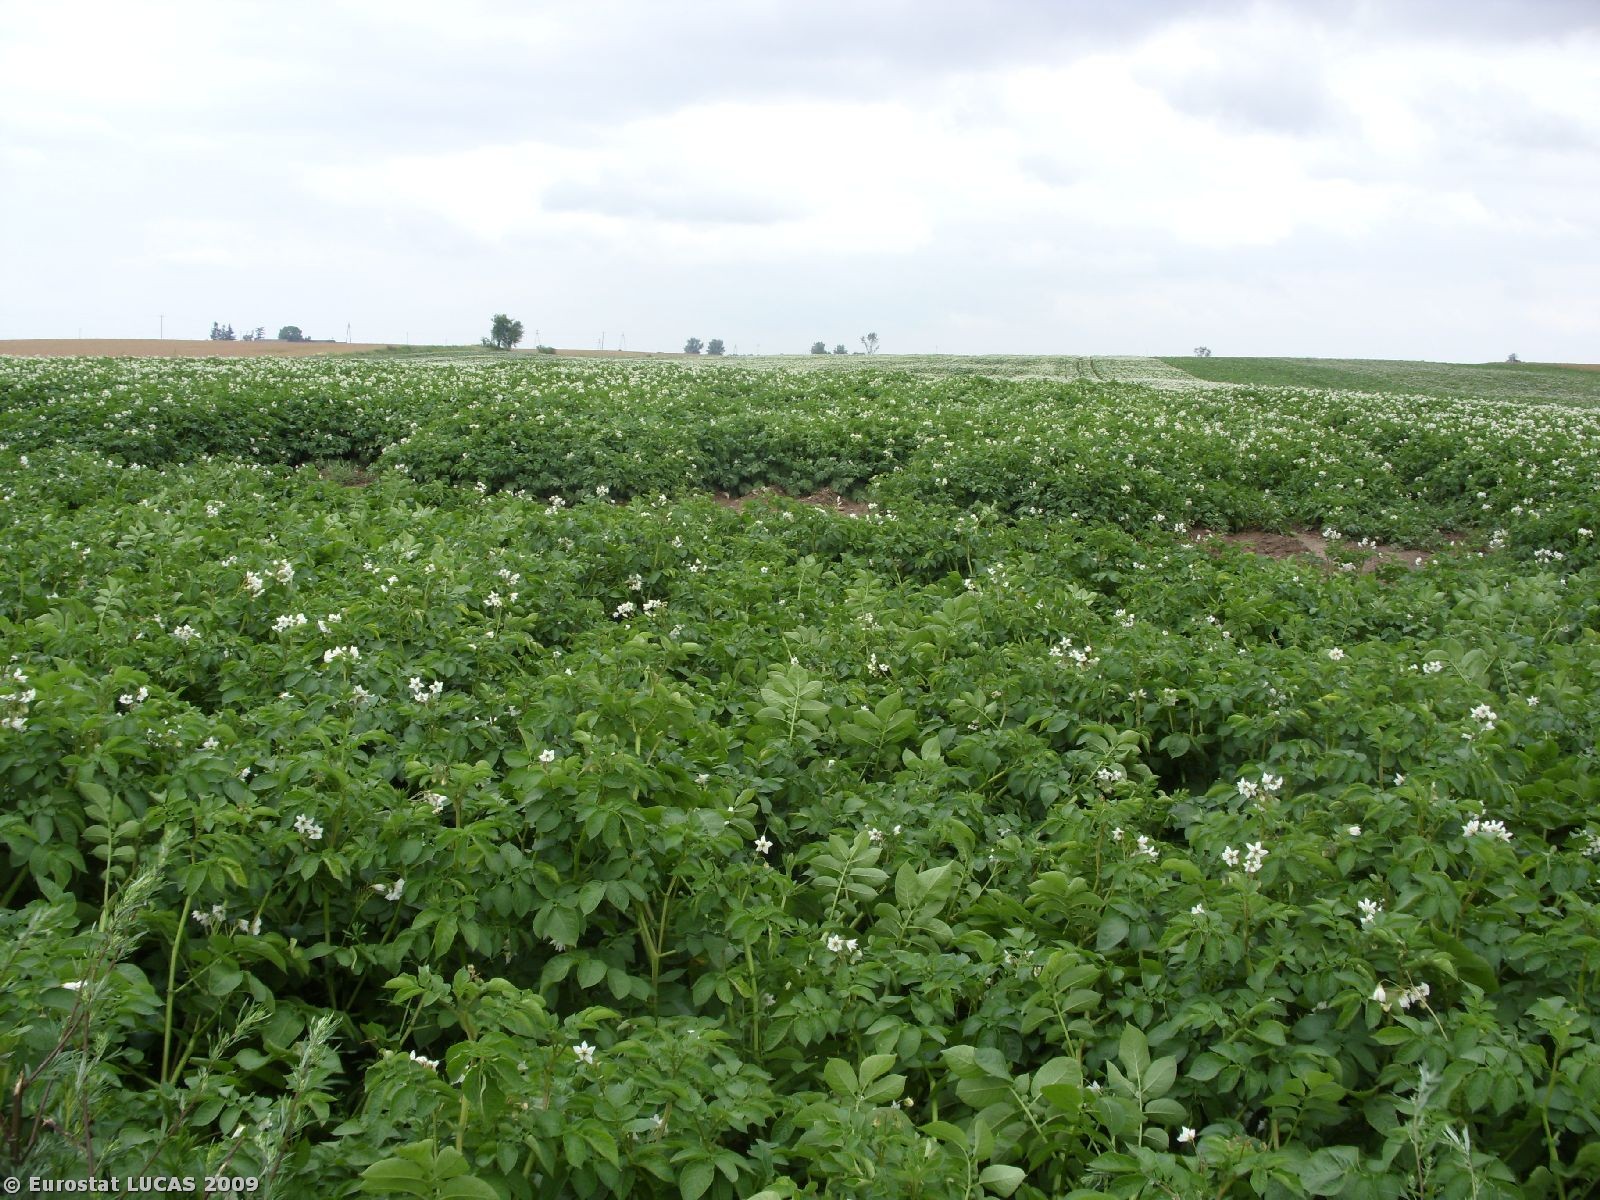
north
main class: Cropland
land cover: Potatoes
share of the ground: > 75 %
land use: Agriculture (excluding fallow land and kitchen gardens)
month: July
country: PL
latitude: 54.0303
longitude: 15.5754
